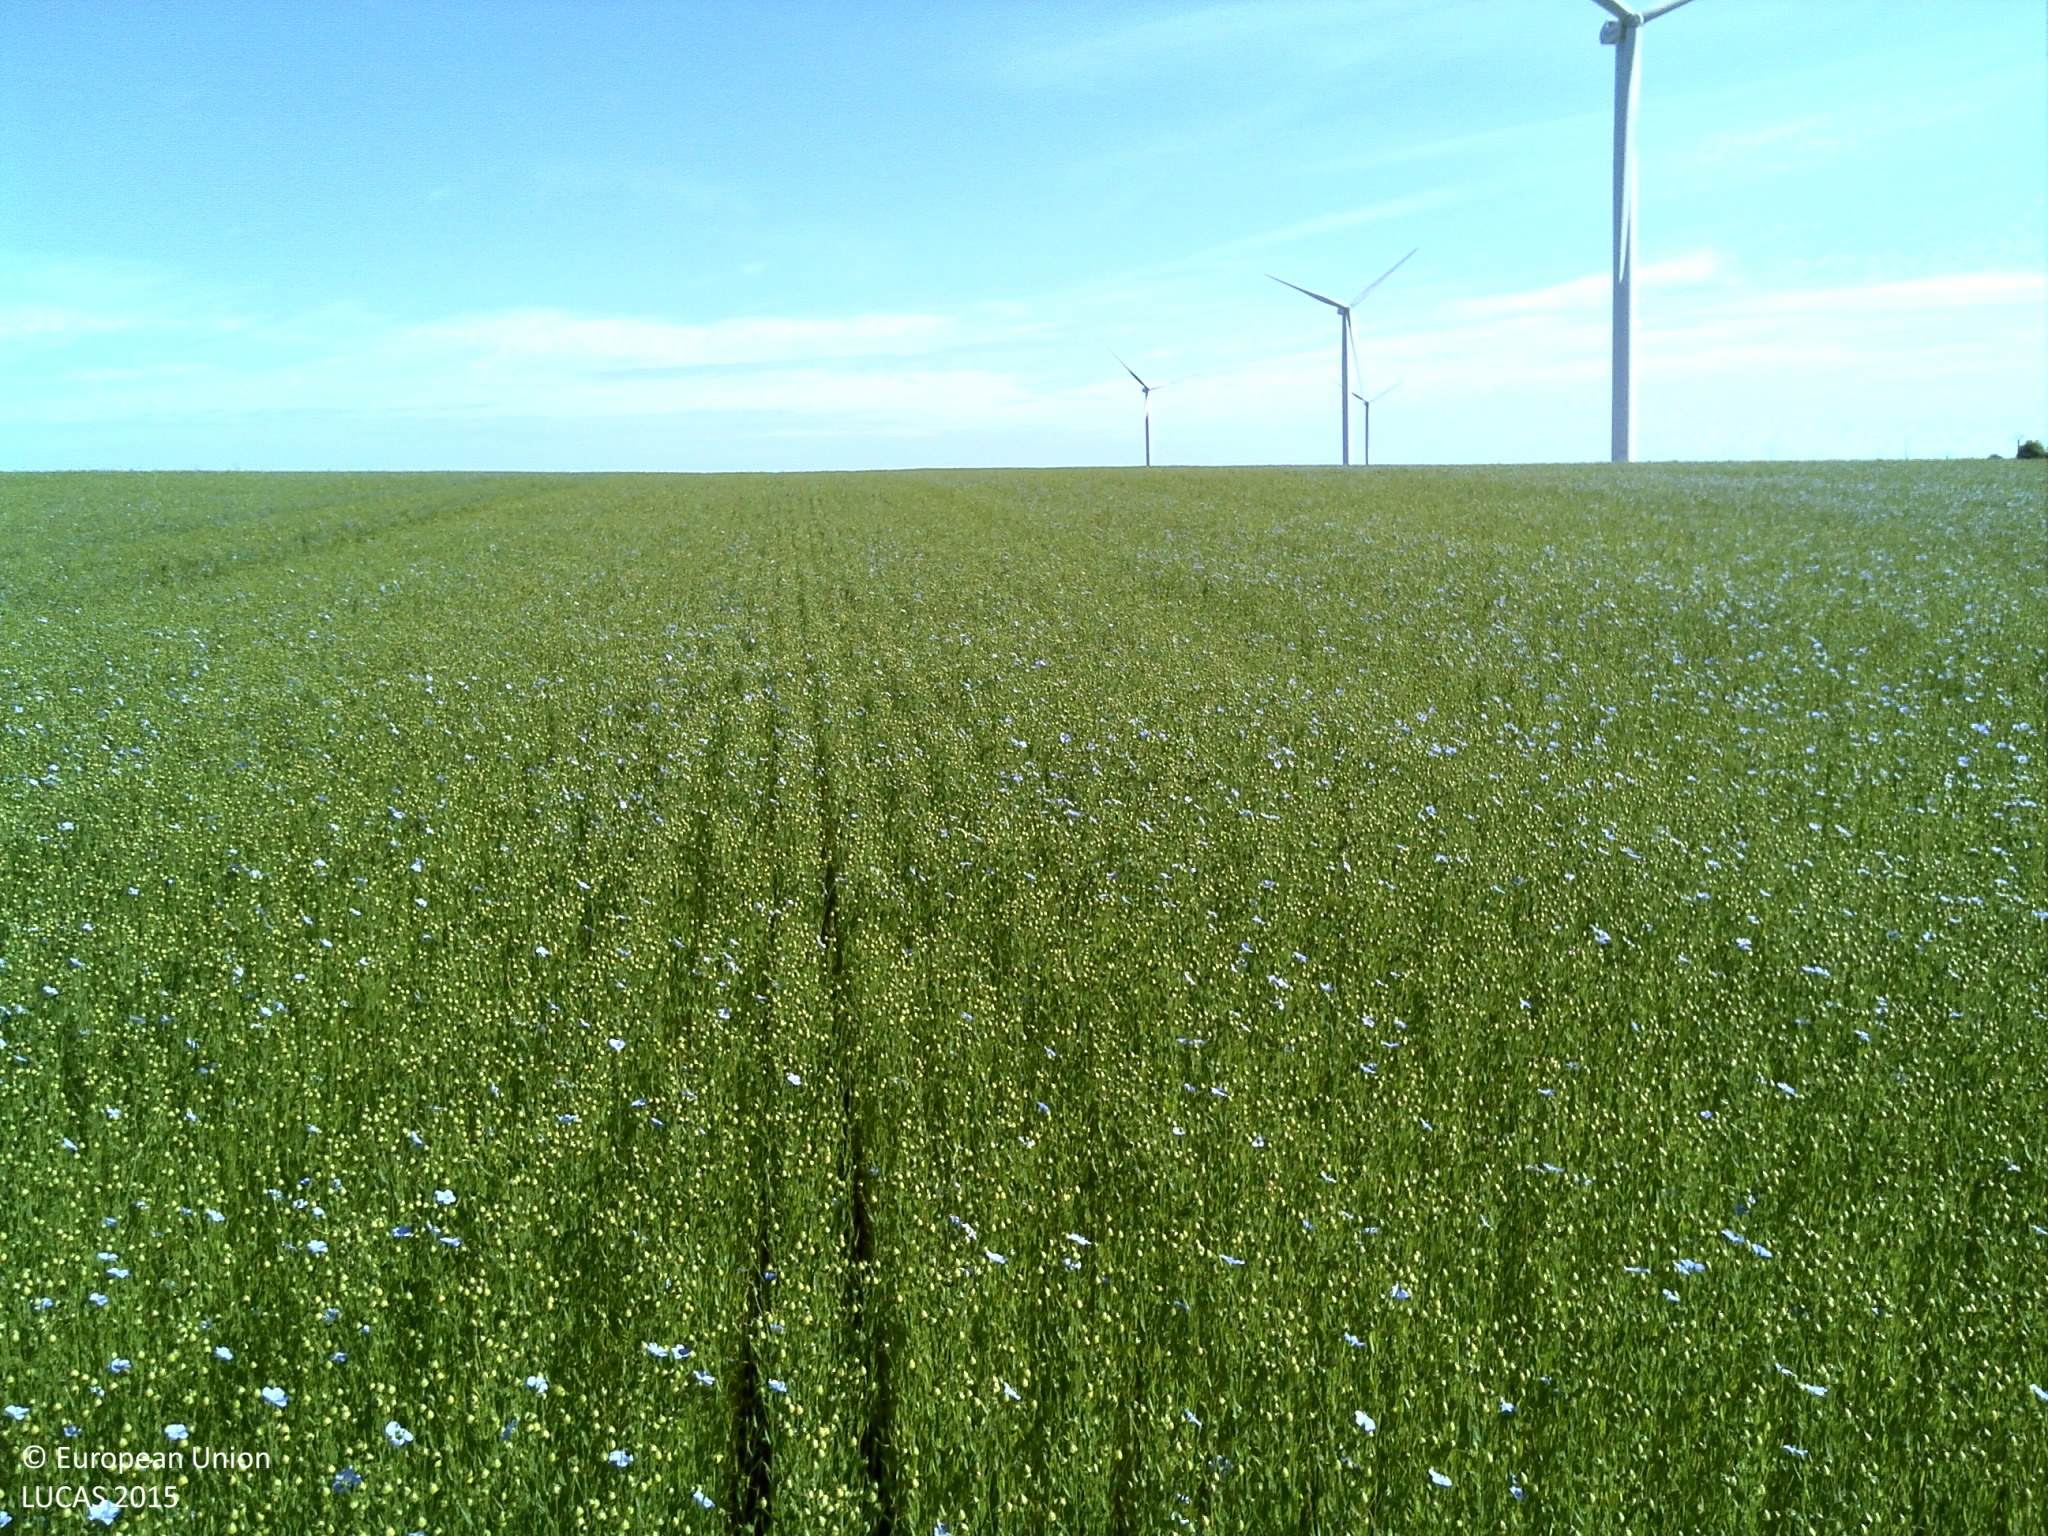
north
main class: Cropland
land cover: Other fibre and oleaginous crops
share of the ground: > 75 %
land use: Agriculture (excluding fallow land and kitchen gardens)
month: June
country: FR
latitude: 49.8041
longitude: 0.9314
